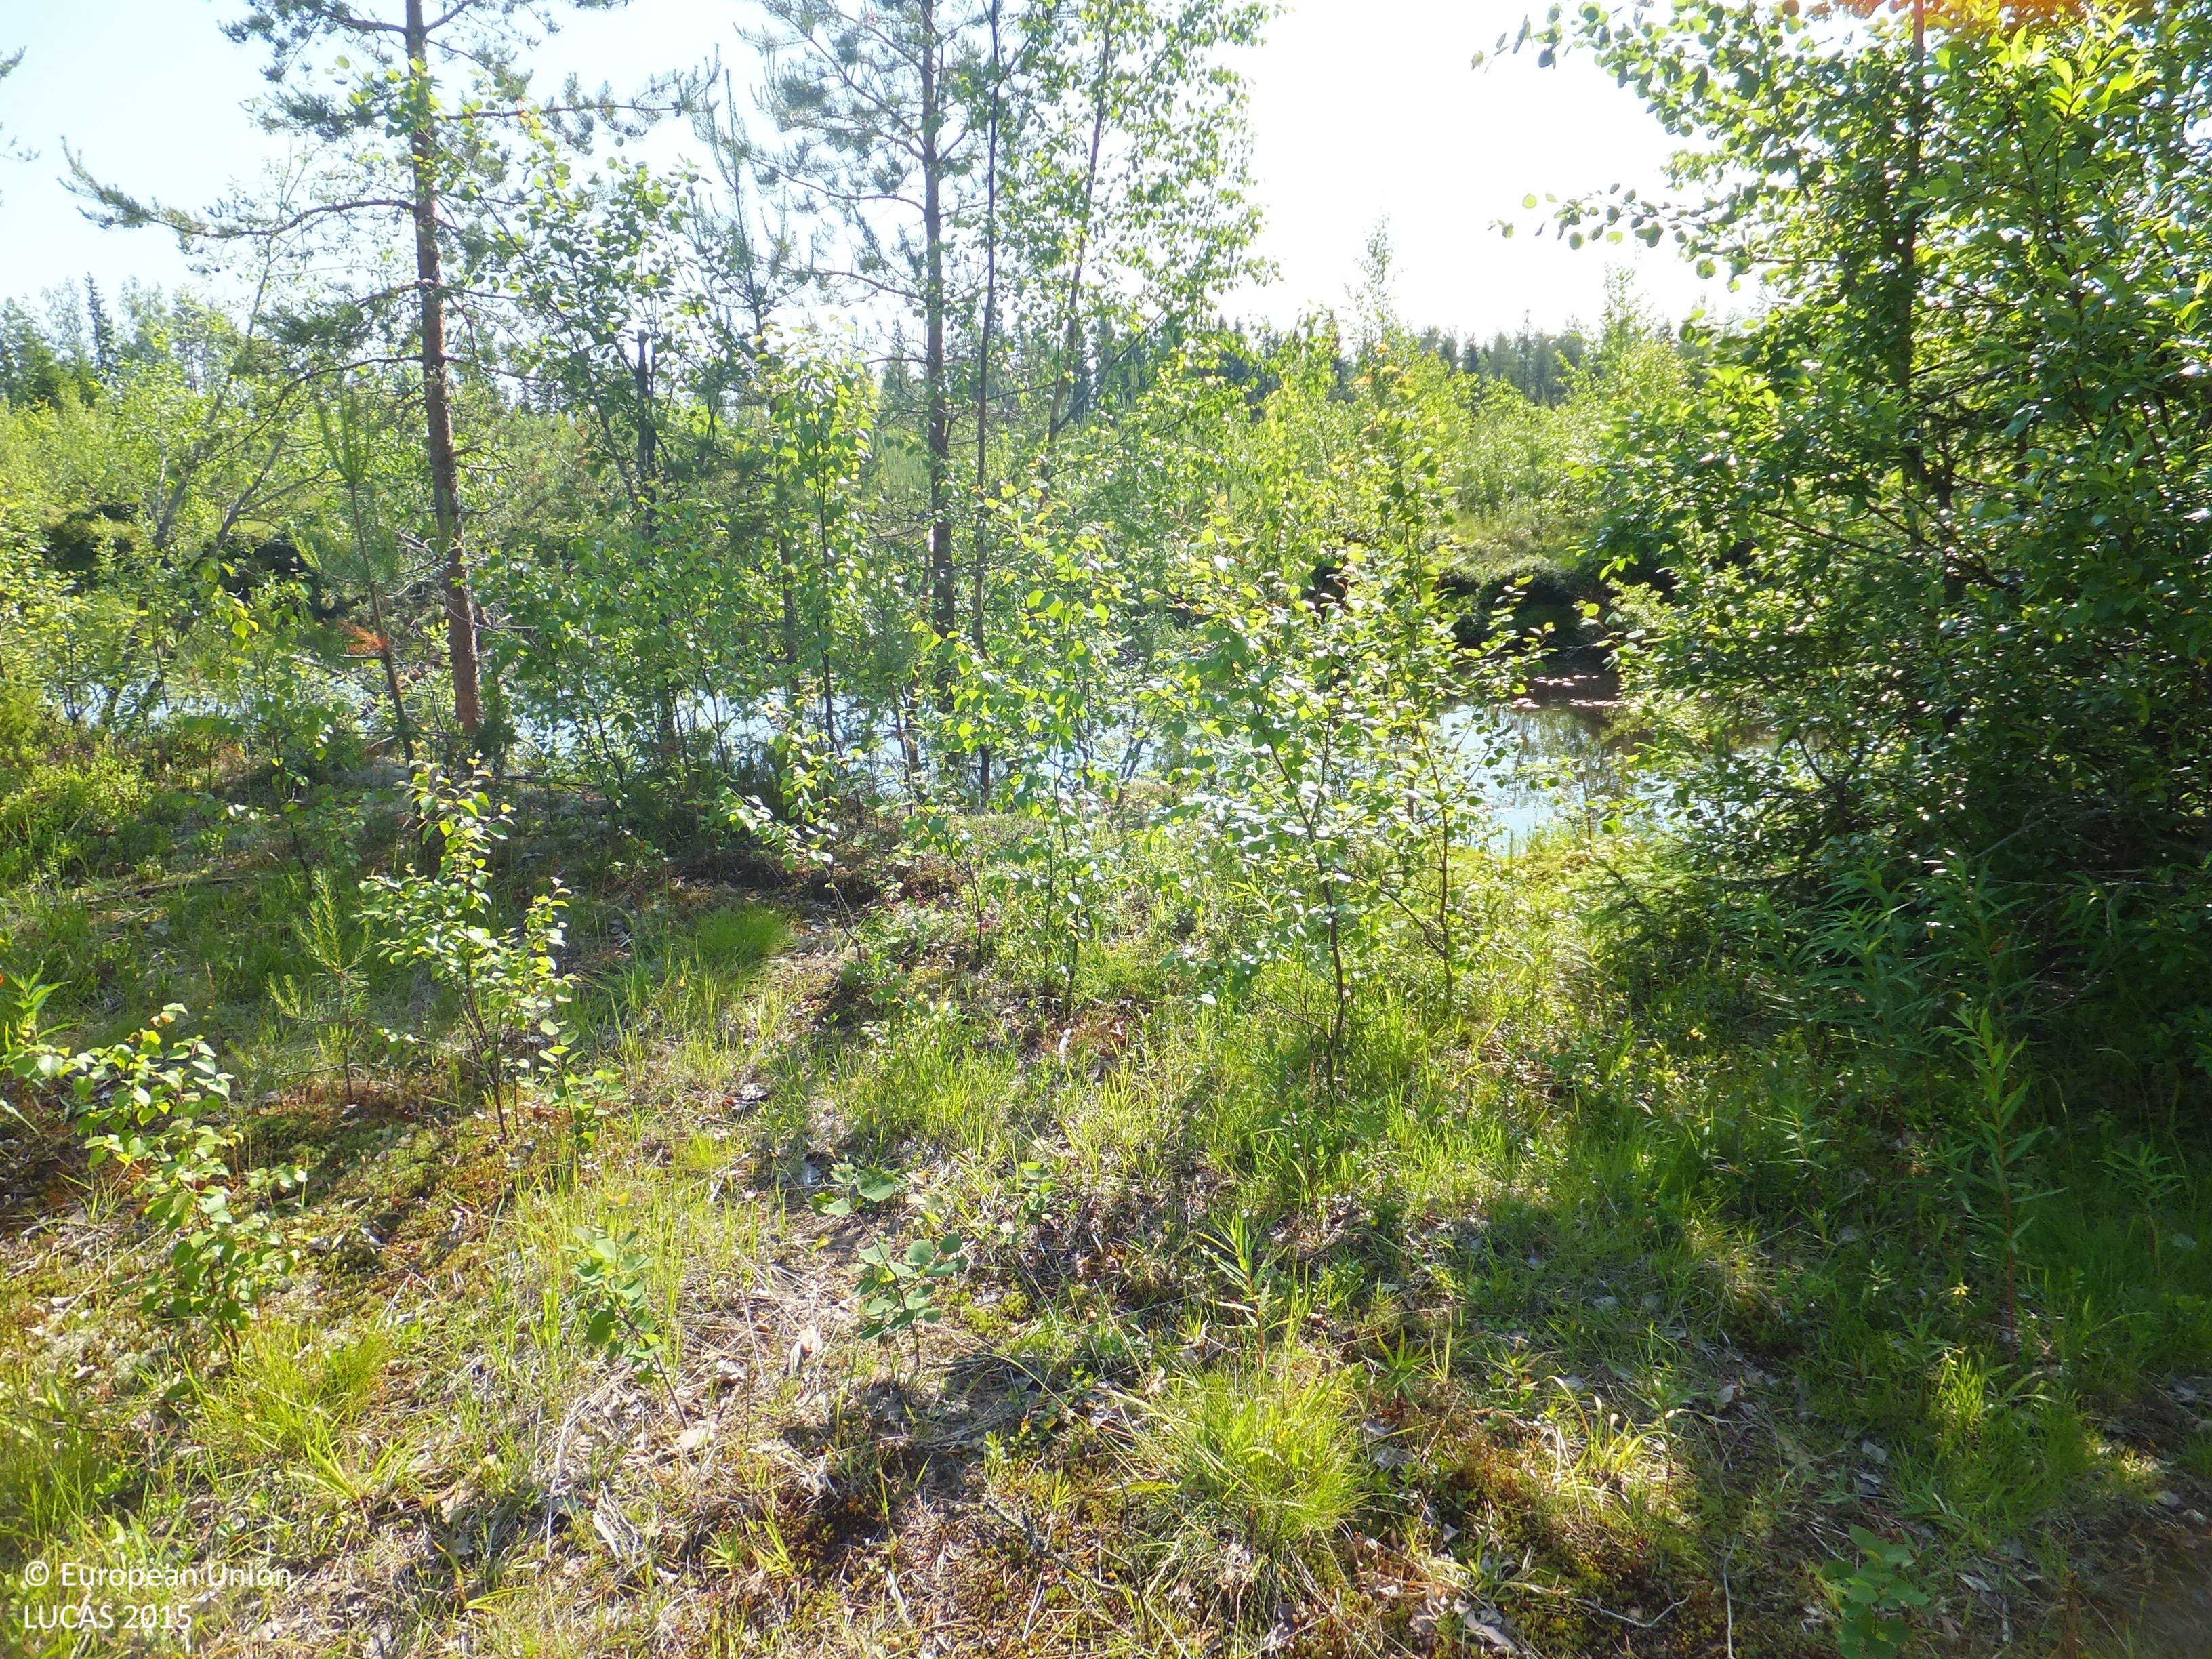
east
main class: Woodland
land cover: Pine dominated mixed woodland
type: boreal forest
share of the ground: 25 - 50 %
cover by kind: coniferous forest trees 20 %, broadleaved forest trees 20 %, herbaceous plants 20 %, unconsolidated bare surface 20 %, shrubs 10 %, lichens and mosses 10 %
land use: Forestry
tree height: < 5 m
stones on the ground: < 10 %
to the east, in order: Pine dominated mixed woodland; Inland fresh water bodies; Pine dominated mixed woodland; Broadleaved woodland; Spruce dominated mixed woodland; Tracks; Ditches and canals; Other mixed woodland; Pine dominated mixed woodland; Ditches and canals; Pine dominated mixed woodland; Pine dominated coniferous woodland
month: July
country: FI
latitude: 63.2977
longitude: 23.7720
